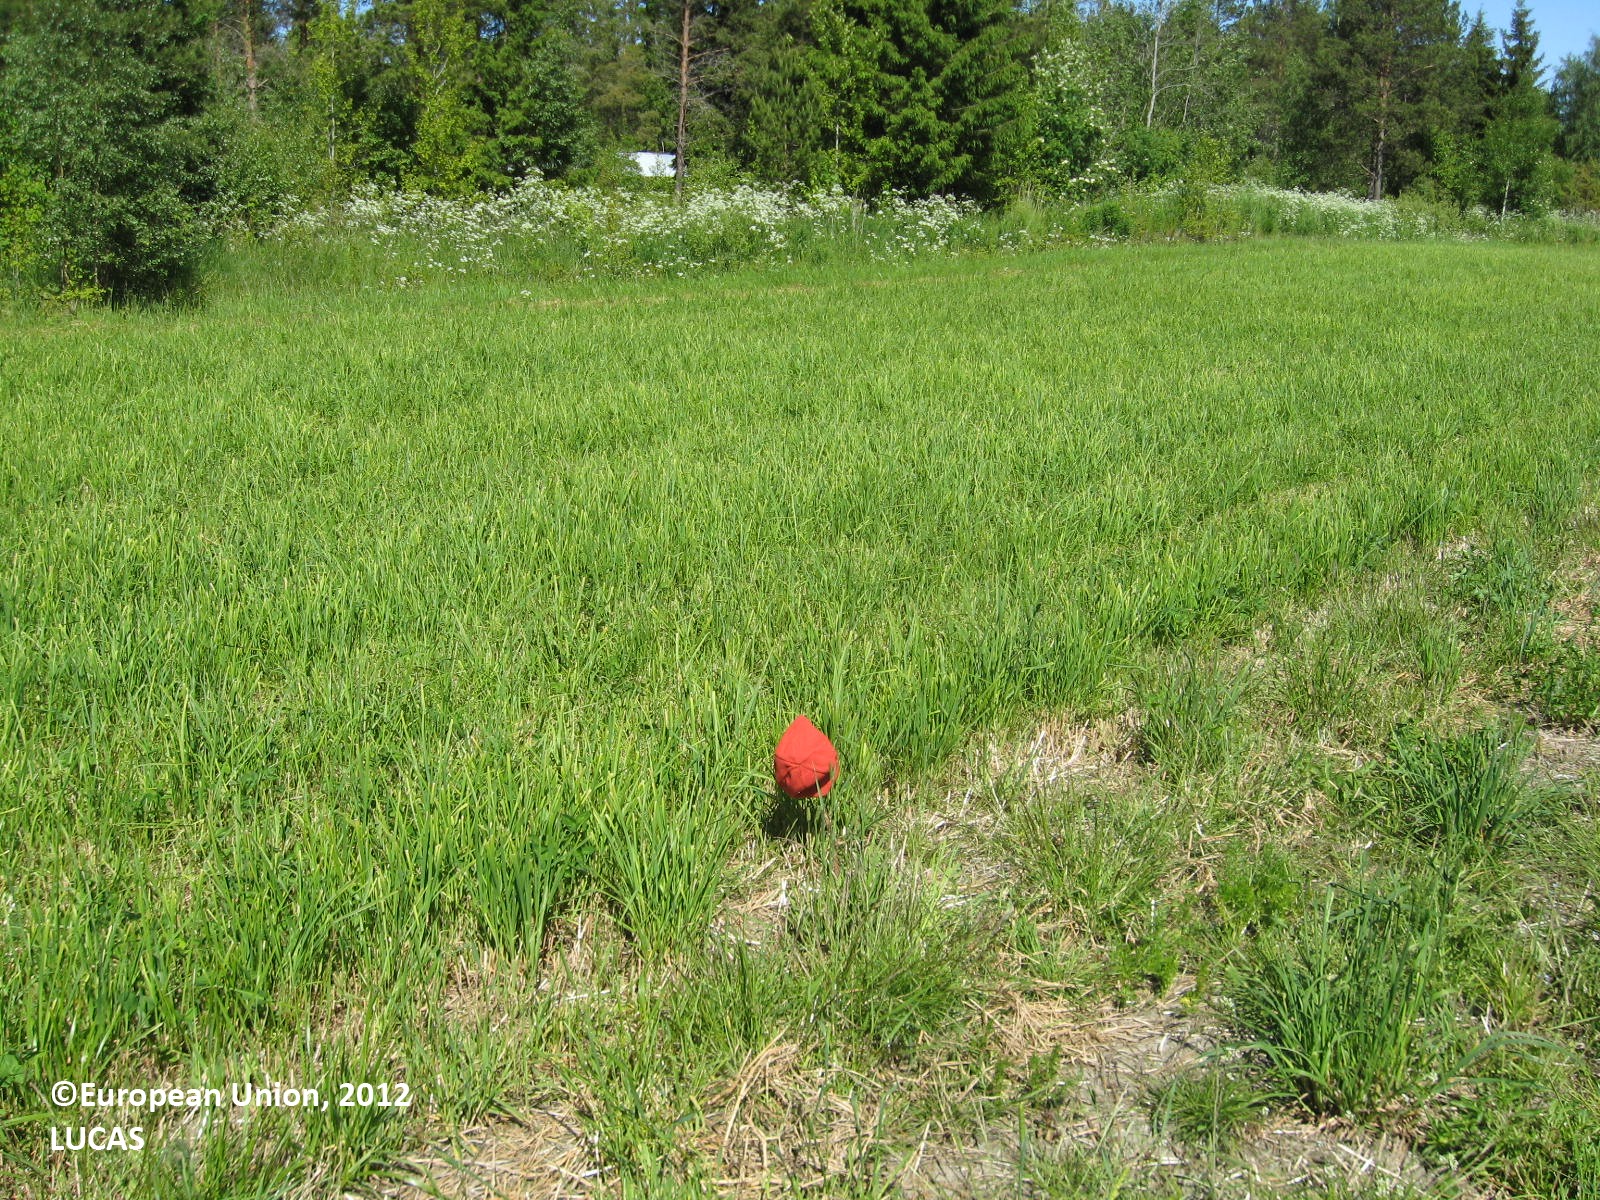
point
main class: Cropland
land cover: Other leguminous and mixtures for fodder
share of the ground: > 75 %
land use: Agriculture (excluding fallow land and kitchen gardens)
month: June
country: FI
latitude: 62.7901
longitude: 21.2713
